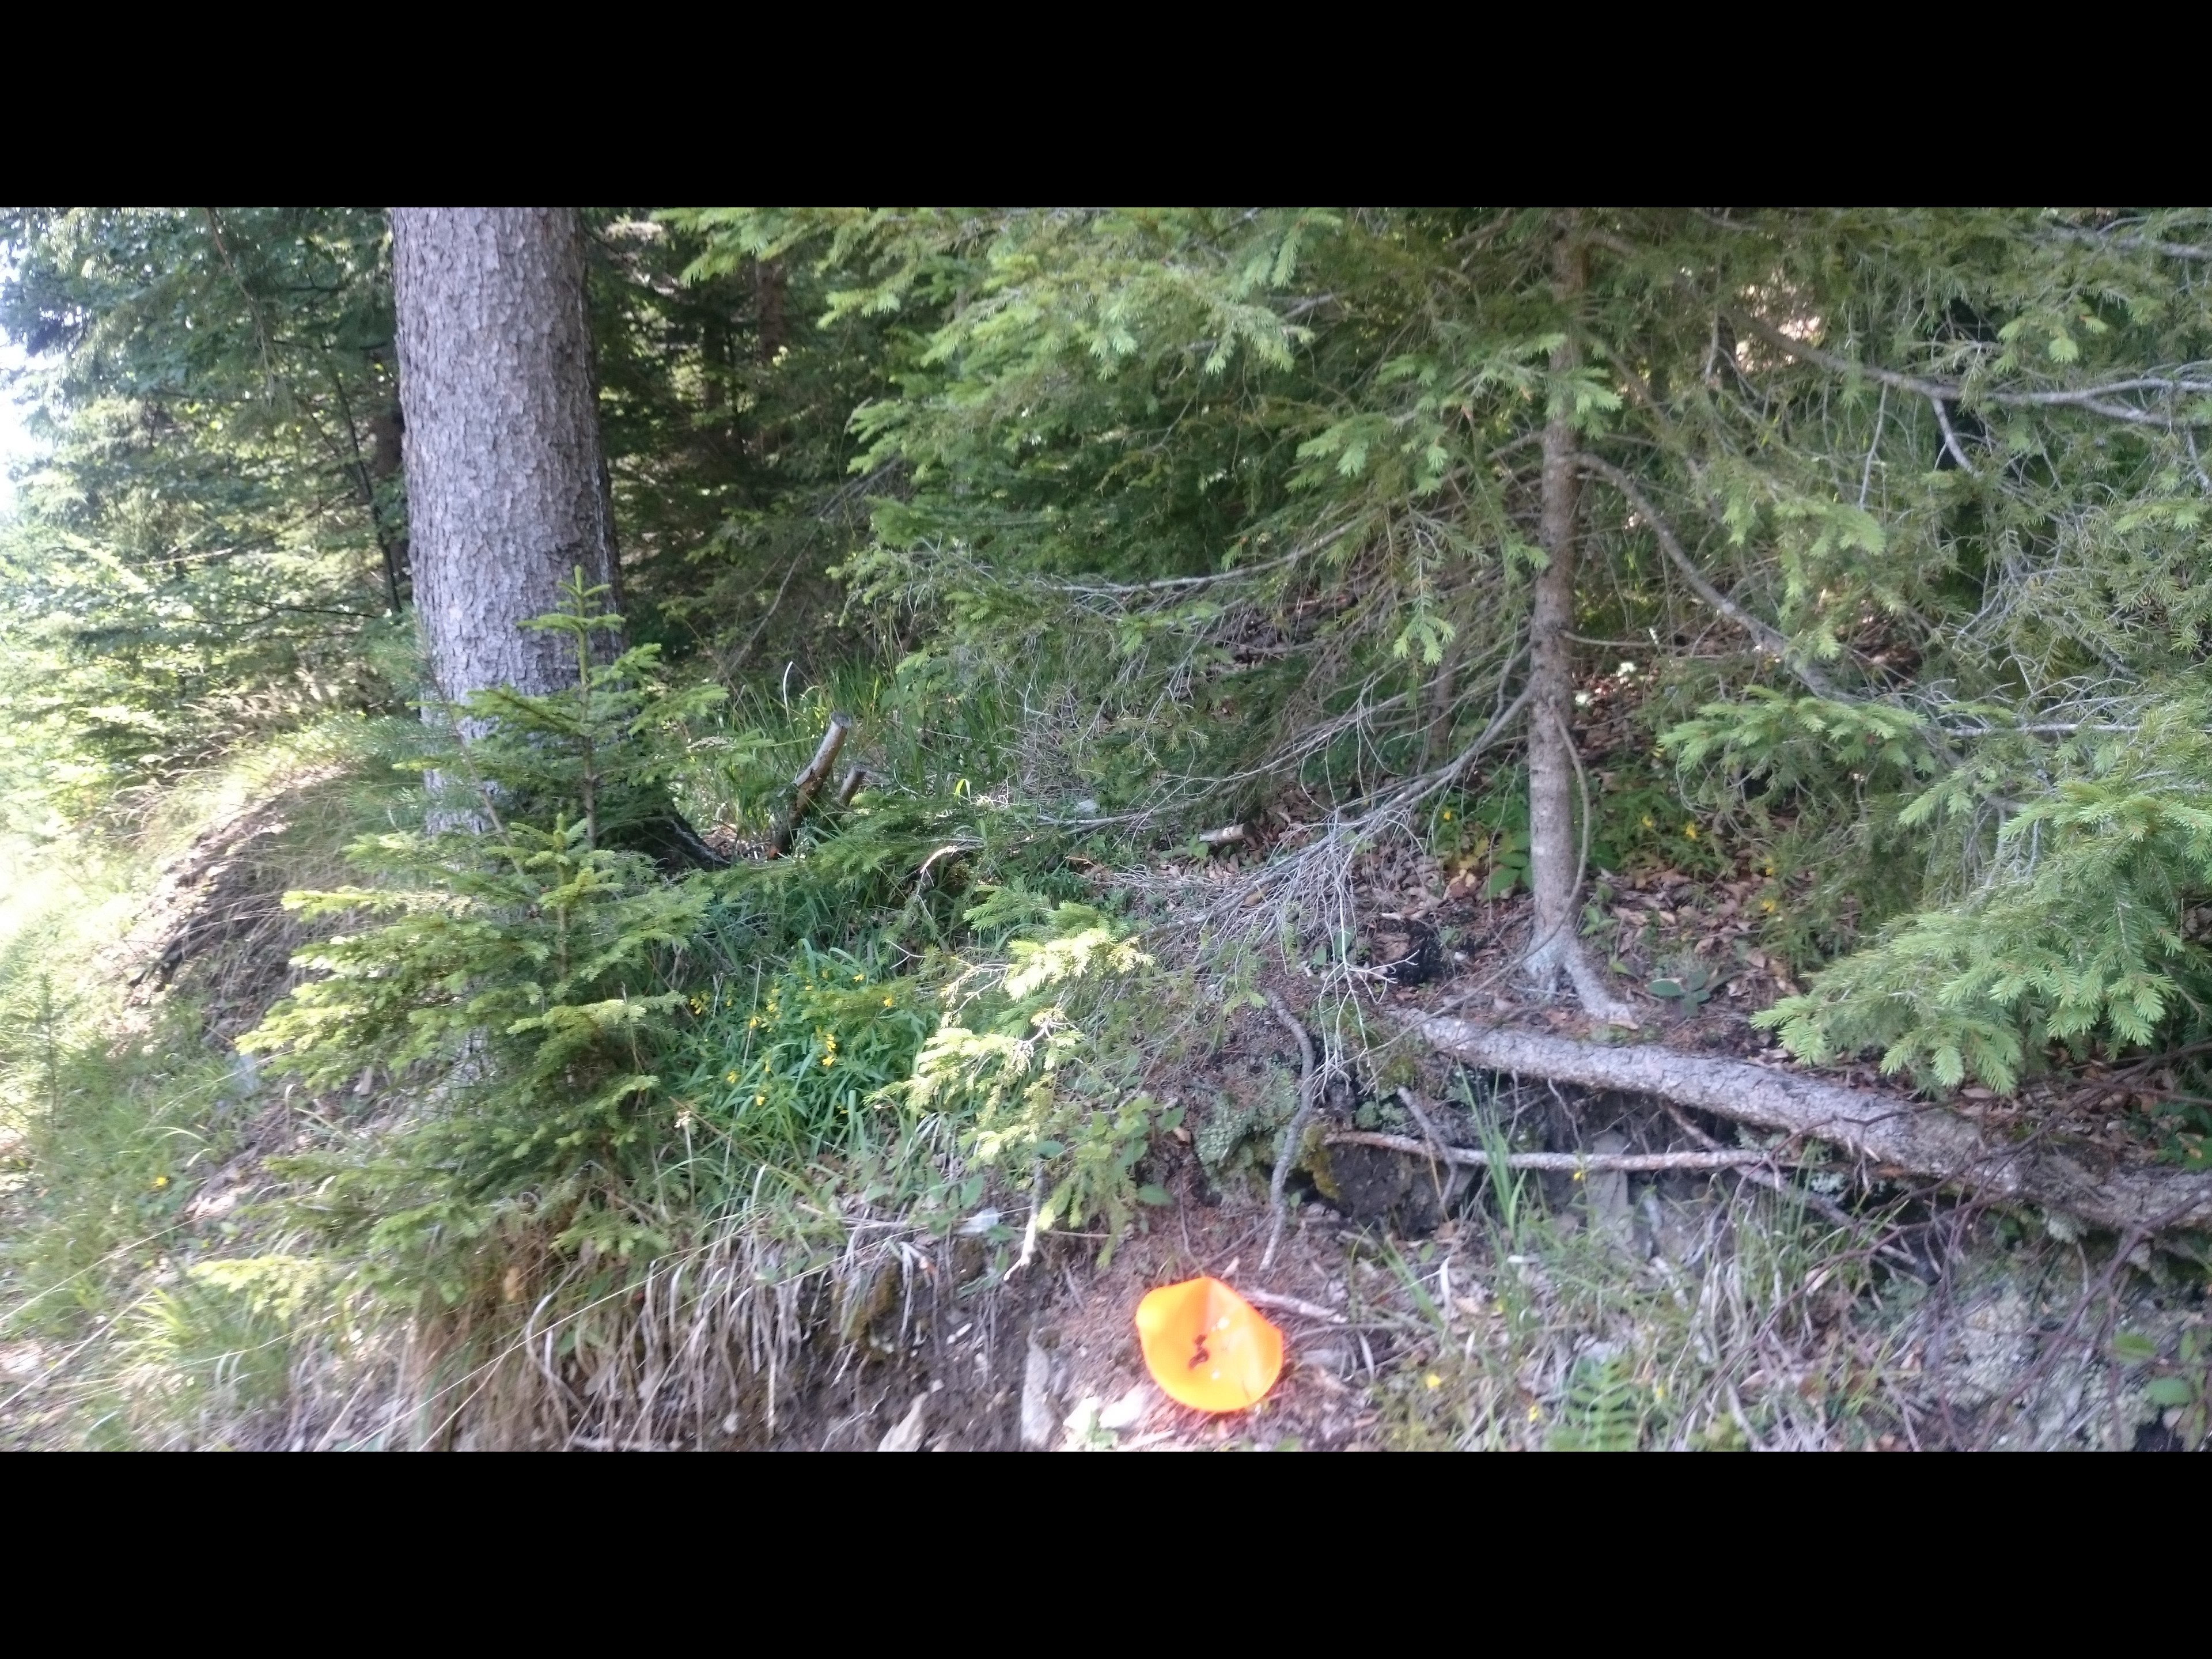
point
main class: Woodland
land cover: Spruce dominated mixed woodland
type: hemiboreal forest and nemoral coniferous forest and mixed broadleaved-coniferous forest
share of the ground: > 75 %
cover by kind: coniferous forest trees 65 %, broadleaved forest trees 25 %, herbaceous plants 10 %
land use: Forestry
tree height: > 5 m
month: July
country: AT
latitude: 47.1855
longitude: 15.4769
